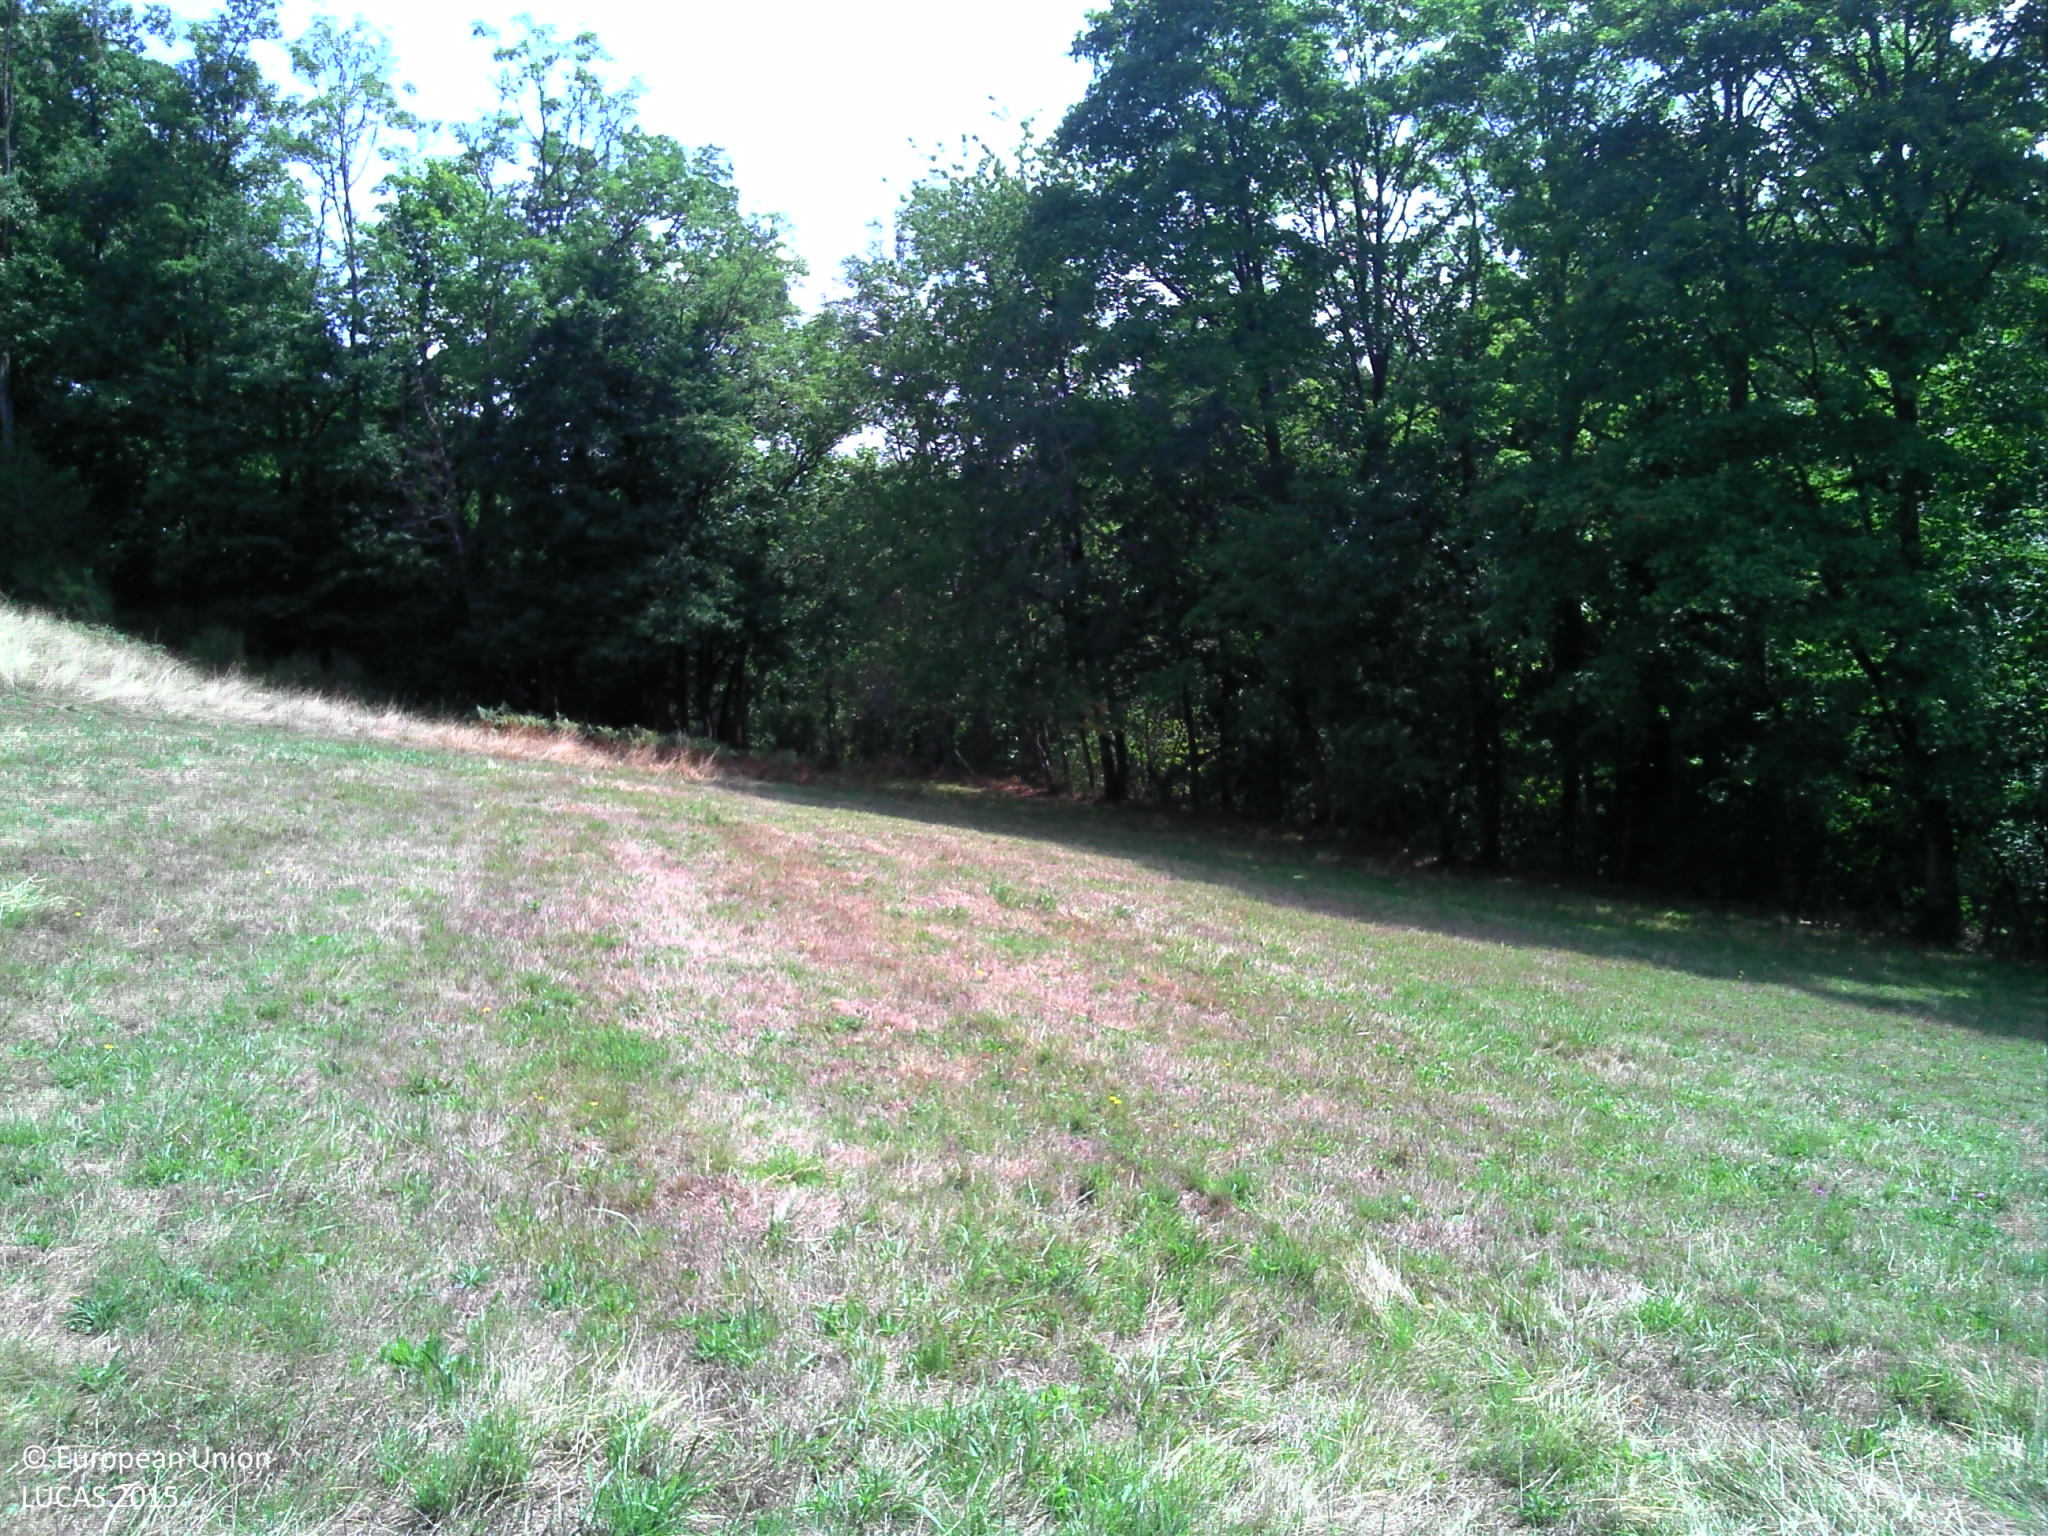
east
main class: Grassland
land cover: Grassland without tree/shrub cover
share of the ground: > 75 %
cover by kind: herbaceous plants 100 %
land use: Agriculture (excluding fallow land and kitchen gardens)
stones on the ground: < 10 %
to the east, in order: Grassland without tree/shrub cover; Fences; Broadleaved woodland; Electric lines; Ditches and canals; Paved roads, cycling and walking lanes; Grass margins; Broadleaved woodland; Dry stone walls; Tracks; Fences; Electric lines; Shrubland without tree cover; Grassland without tree/shrub cover; Fences; Tracks; Fences; Grassland without tree/shrub cover
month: August
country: FR
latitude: 46.1735
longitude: 4.4971
